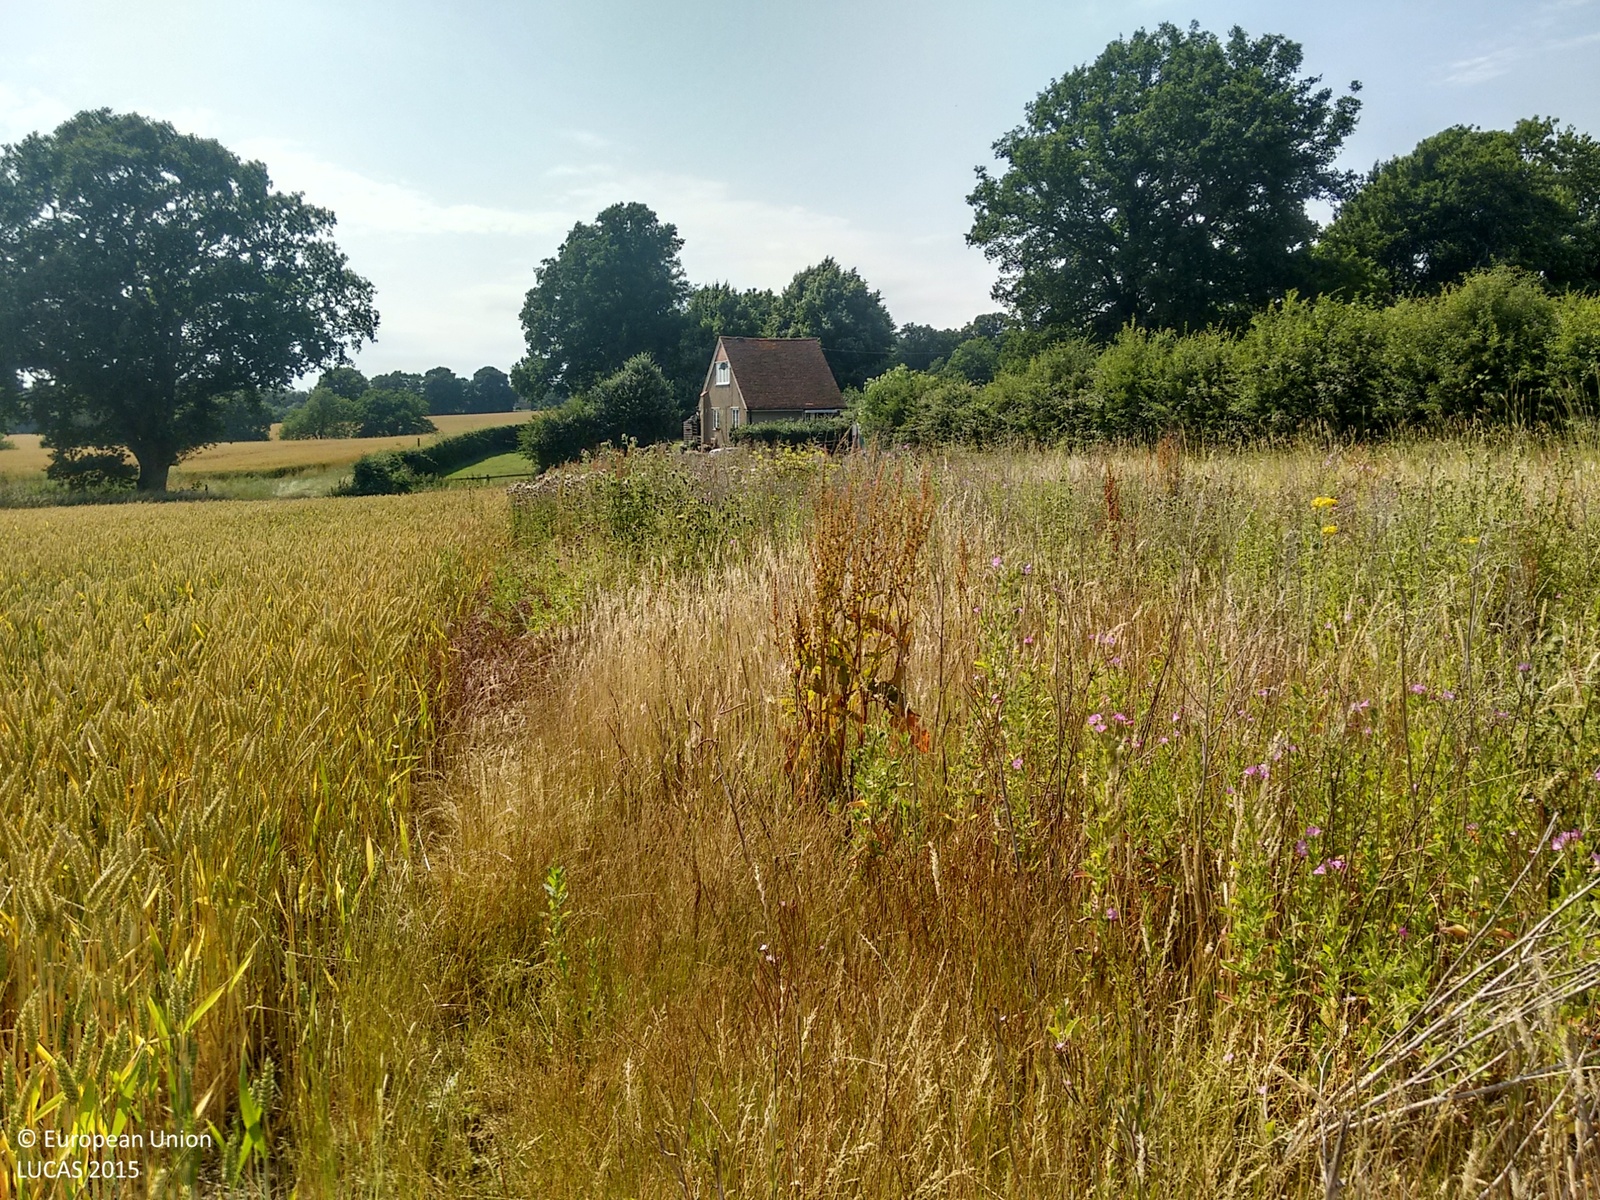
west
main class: Grassland
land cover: Spontaneously vegetated surfaces
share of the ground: > 75 %
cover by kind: herbaceous plants 100 %
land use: Fallow land
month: July
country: GB
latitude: 51.6985
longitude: 0.4075
